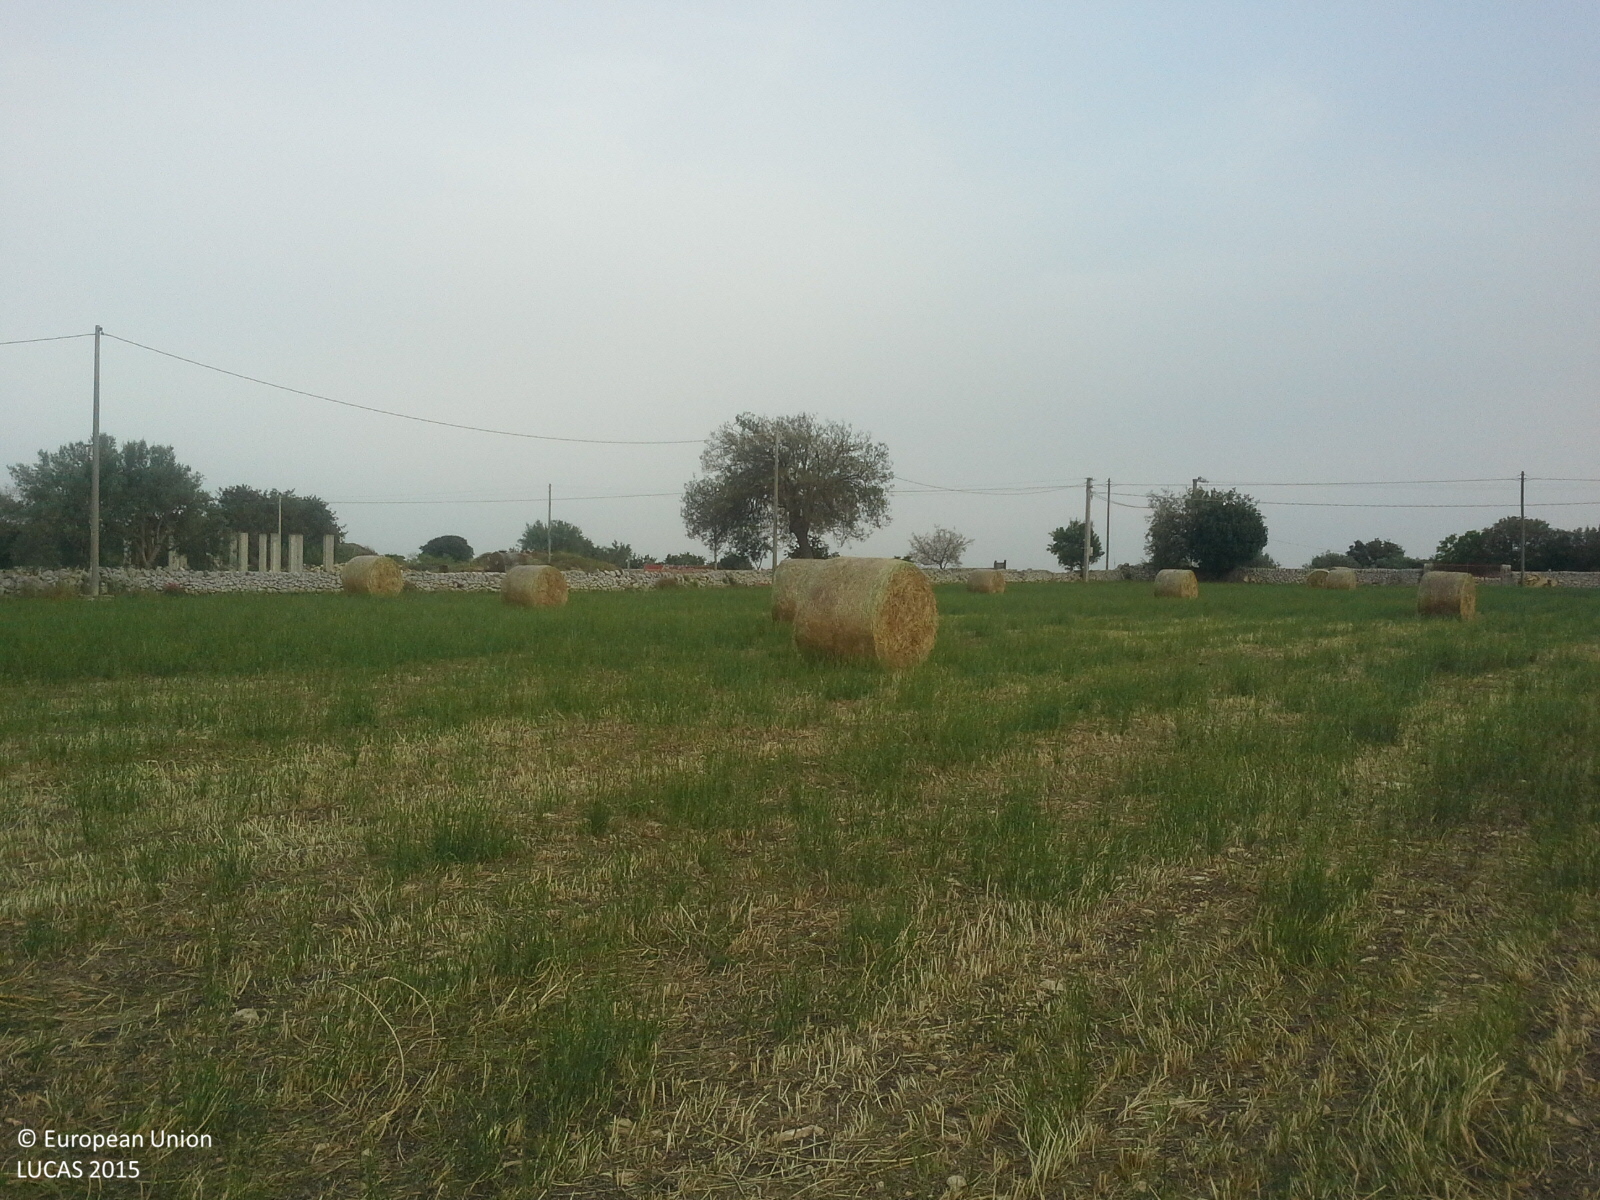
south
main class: Cropland
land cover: Mixed cereals for fodder
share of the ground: > 75 %
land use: Agriculture (excluding fallow land and kitchen gardens)
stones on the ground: < 10 %
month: May
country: IT
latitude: 36.8795
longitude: 14.8196
